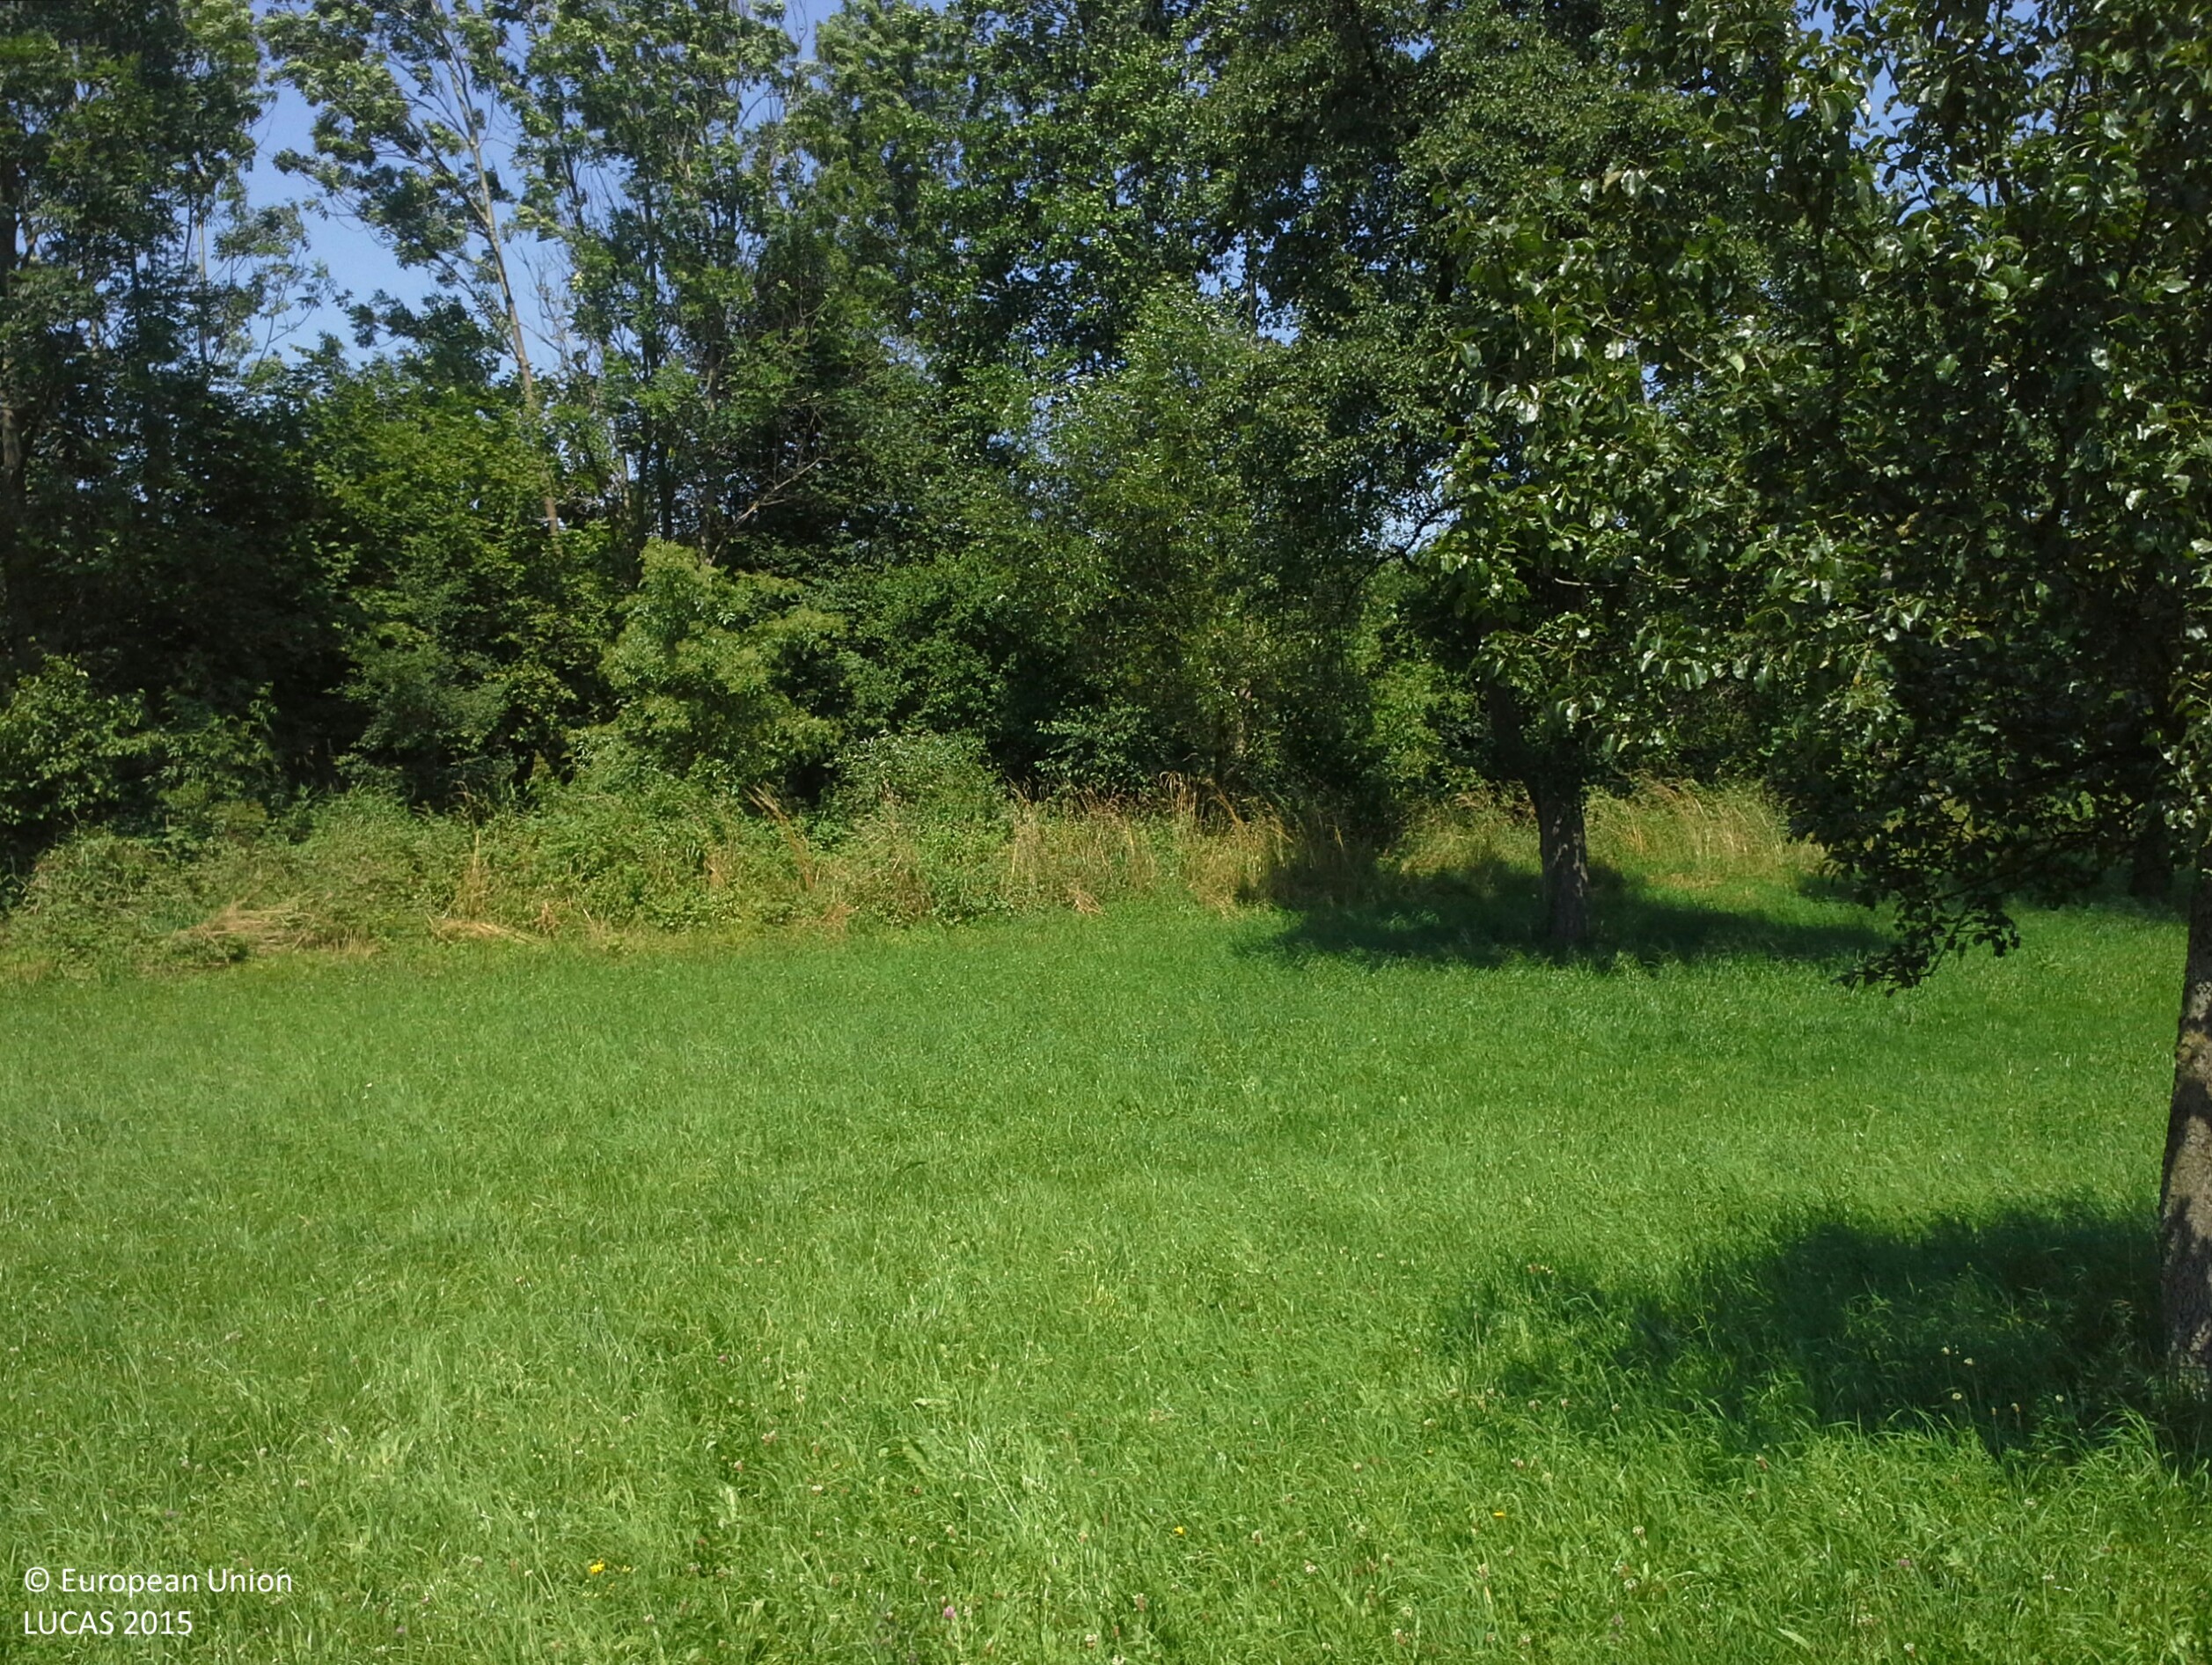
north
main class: Cropland
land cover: Pear fruit
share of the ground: 10 - 25 %
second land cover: Grassland without tree/shrub cover
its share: > 75 %
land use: Agriculture (excluding fallow land and kitchen gardens)
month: July
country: AT
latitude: 48.1276
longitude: 15.0126
